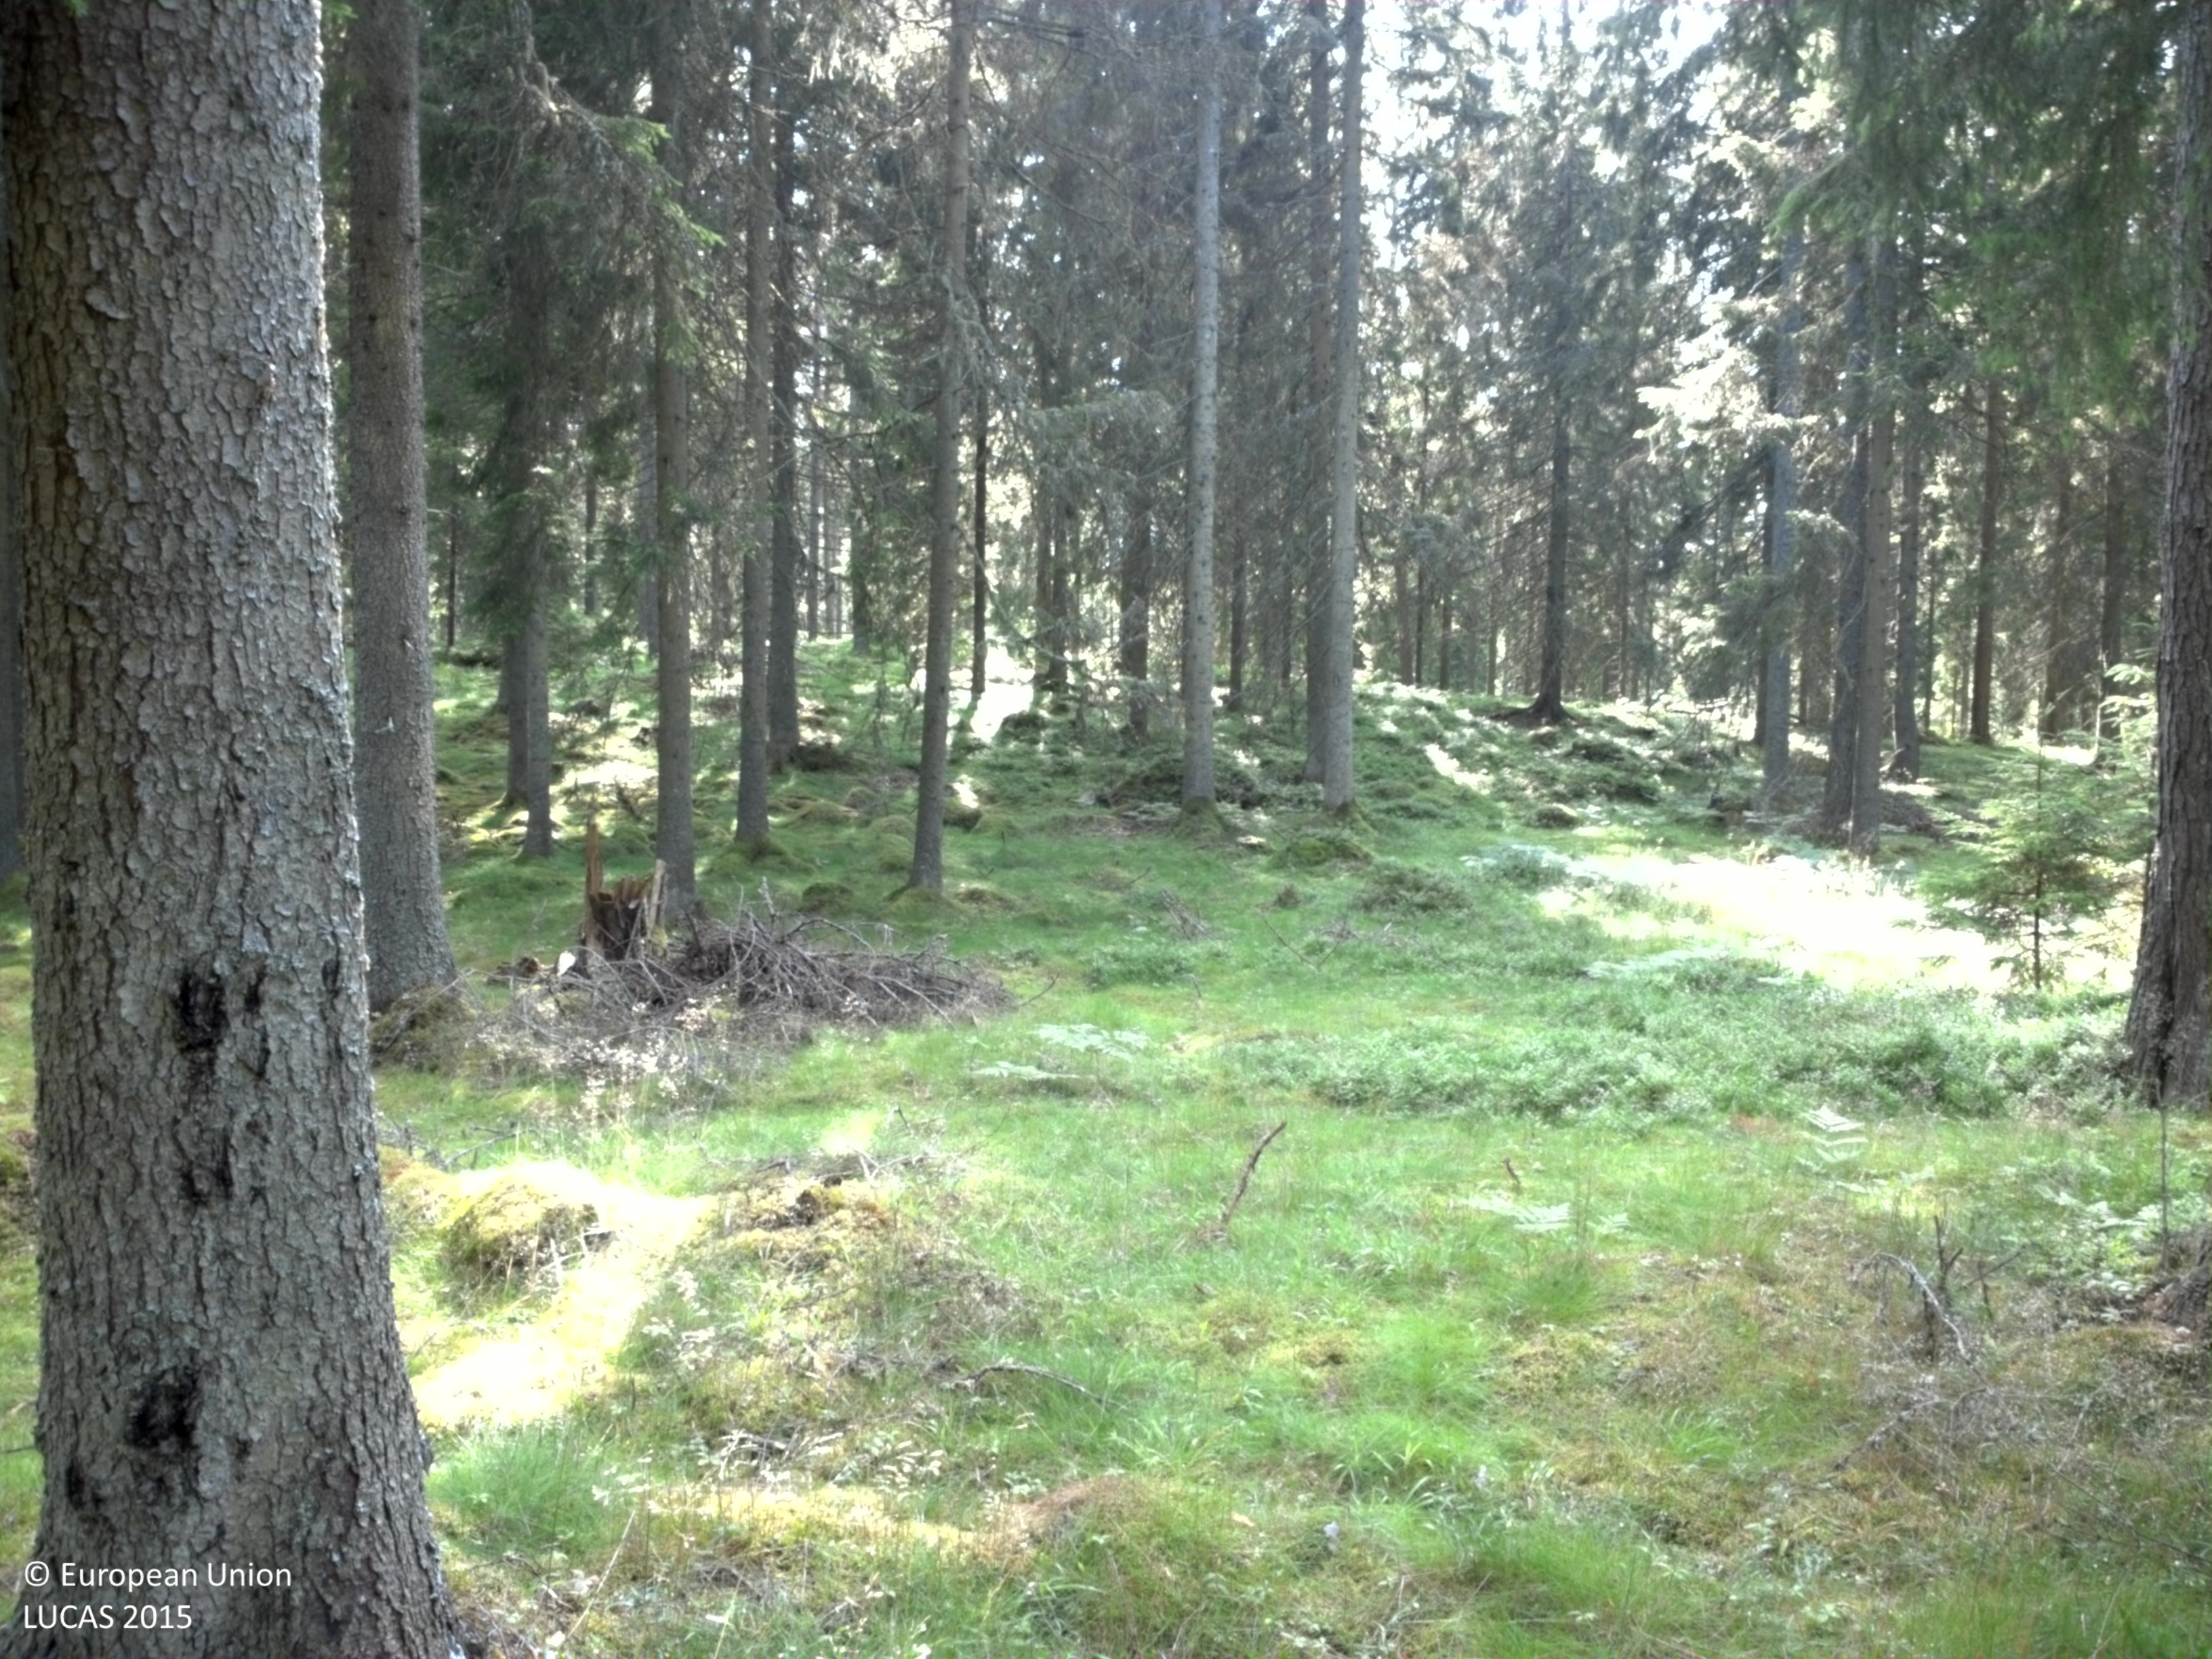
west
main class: Woodland
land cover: Other coniferous woodland
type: boreal forest
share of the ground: 25 - 50 %
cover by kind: coniferous forest trees 45 %, lichens and mosses 30 %, herbaceous plants 25 %
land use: Forestry
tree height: > 5 m
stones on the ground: < 10 %
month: July
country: SE
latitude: 58.5100
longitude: 14.3360
